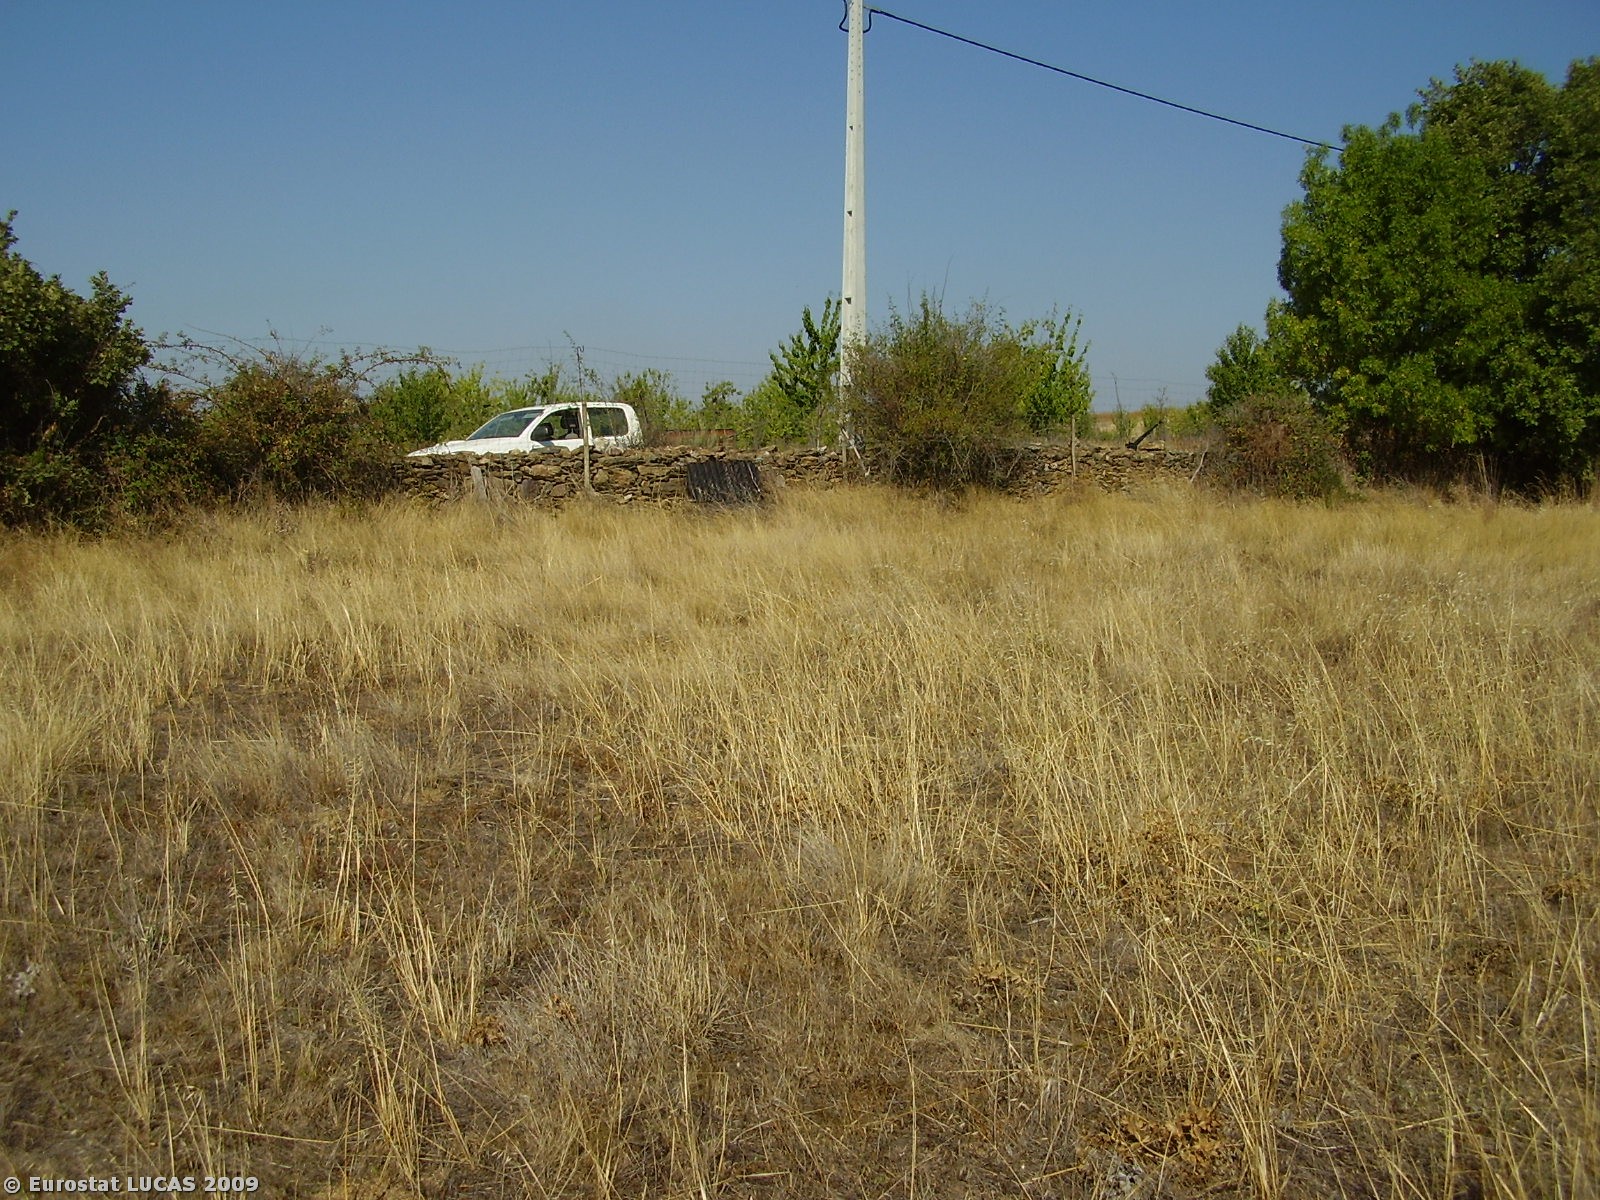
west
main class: Grassland
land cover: Grassland without tree/shrub cover
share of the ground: > 75 %
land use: Fallow land
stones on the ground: > 50 %
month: August
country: PT
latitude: 41.3431
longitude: -6.7291
